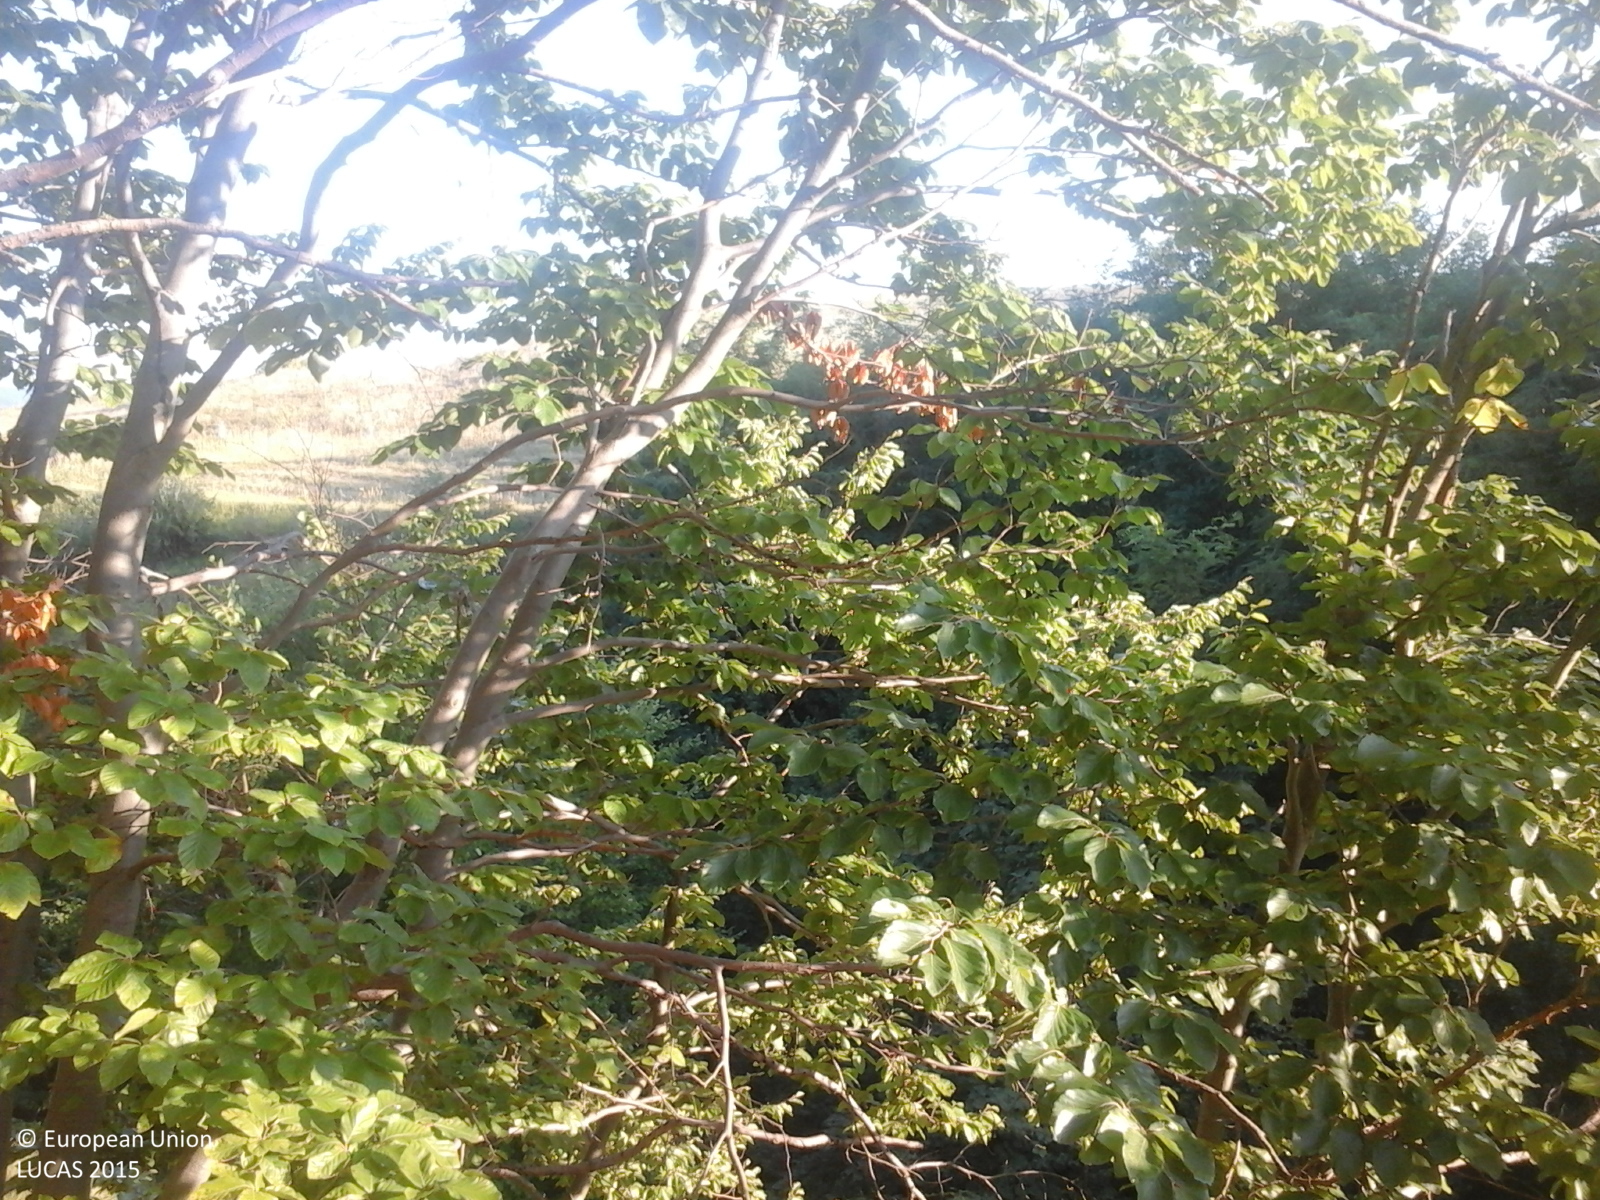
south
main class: Woodland
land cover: Broadleaved woodland
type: beech forest
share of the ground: > 75 %
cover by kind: broadleaved forest trees 100 %
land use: Forestry
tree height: > 5 m
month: August
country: RO
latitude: 46.3068
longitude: 26.8531
